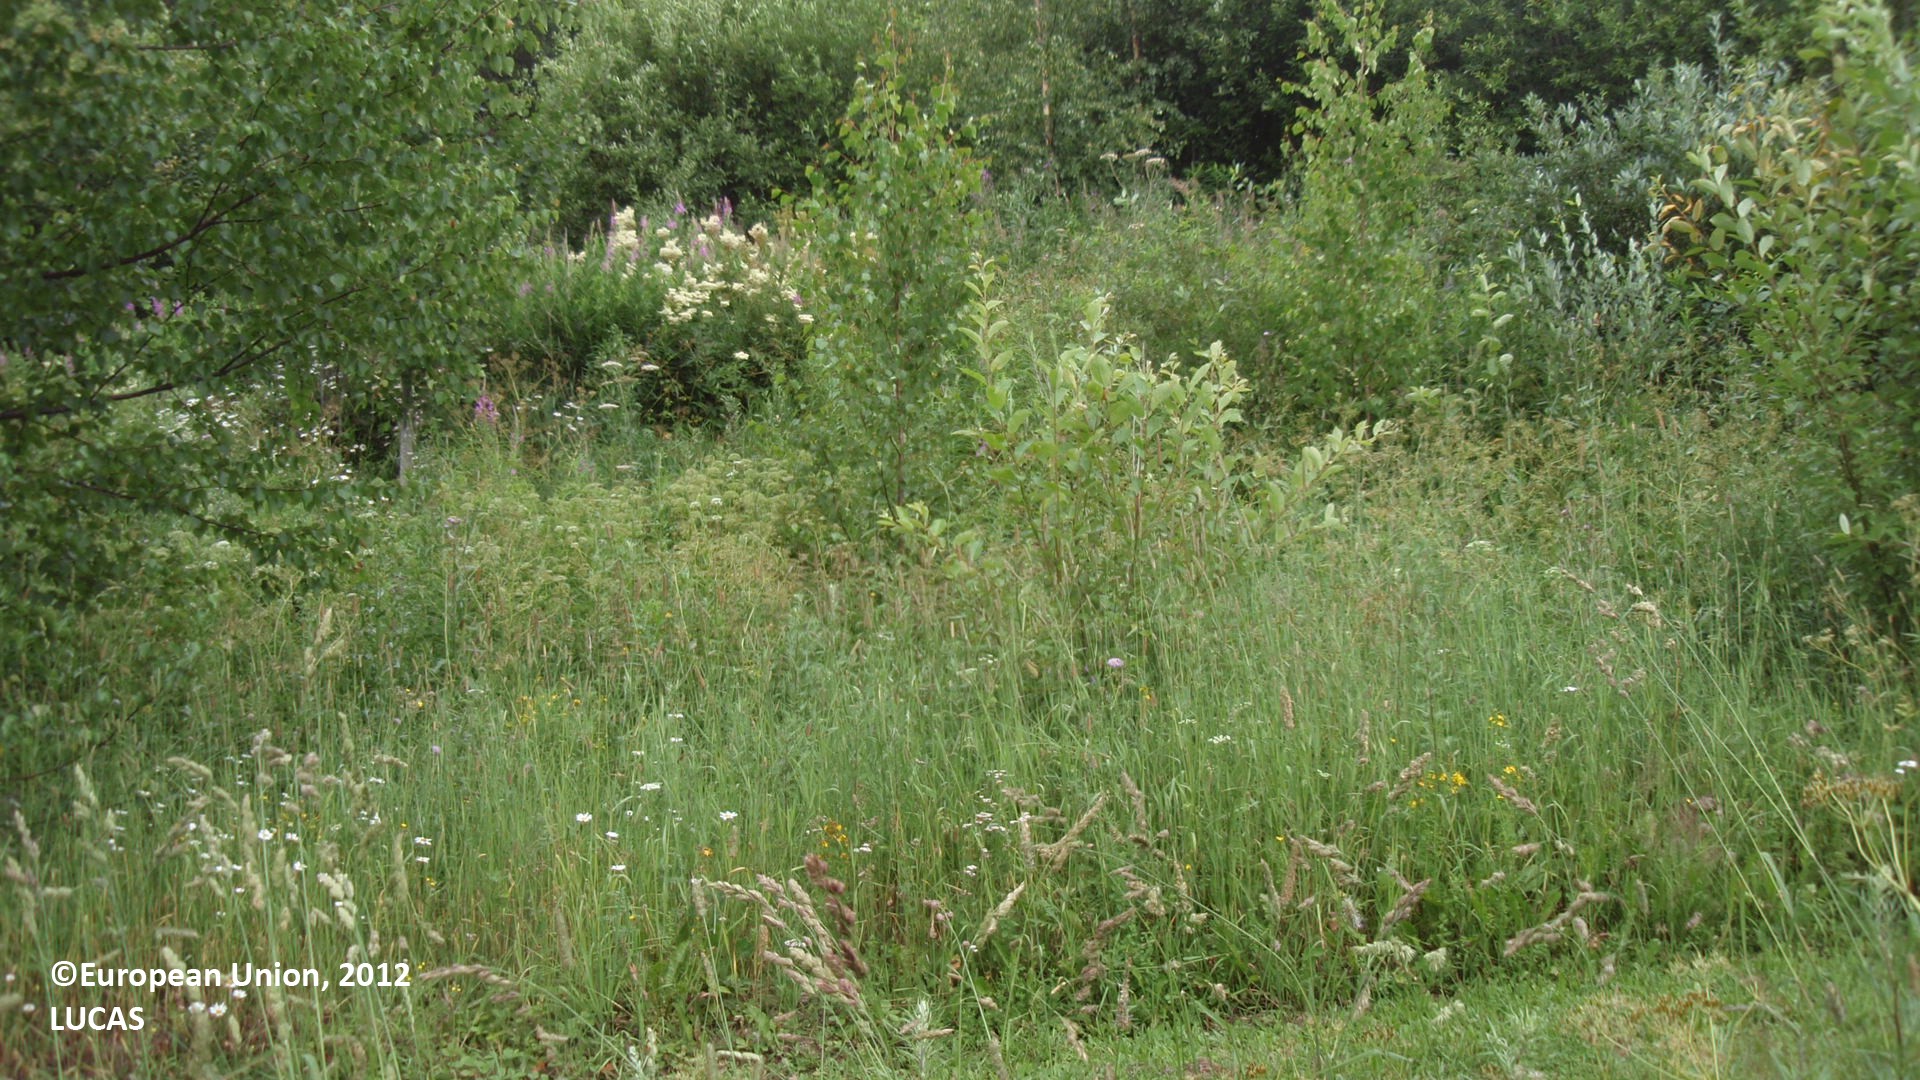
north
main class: Grassland
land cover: Grassland without tree/shrub cover
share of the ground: 50 - 75 %
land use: Fallow land
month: July
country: FI
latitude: 61.0704
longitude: 28.5458
